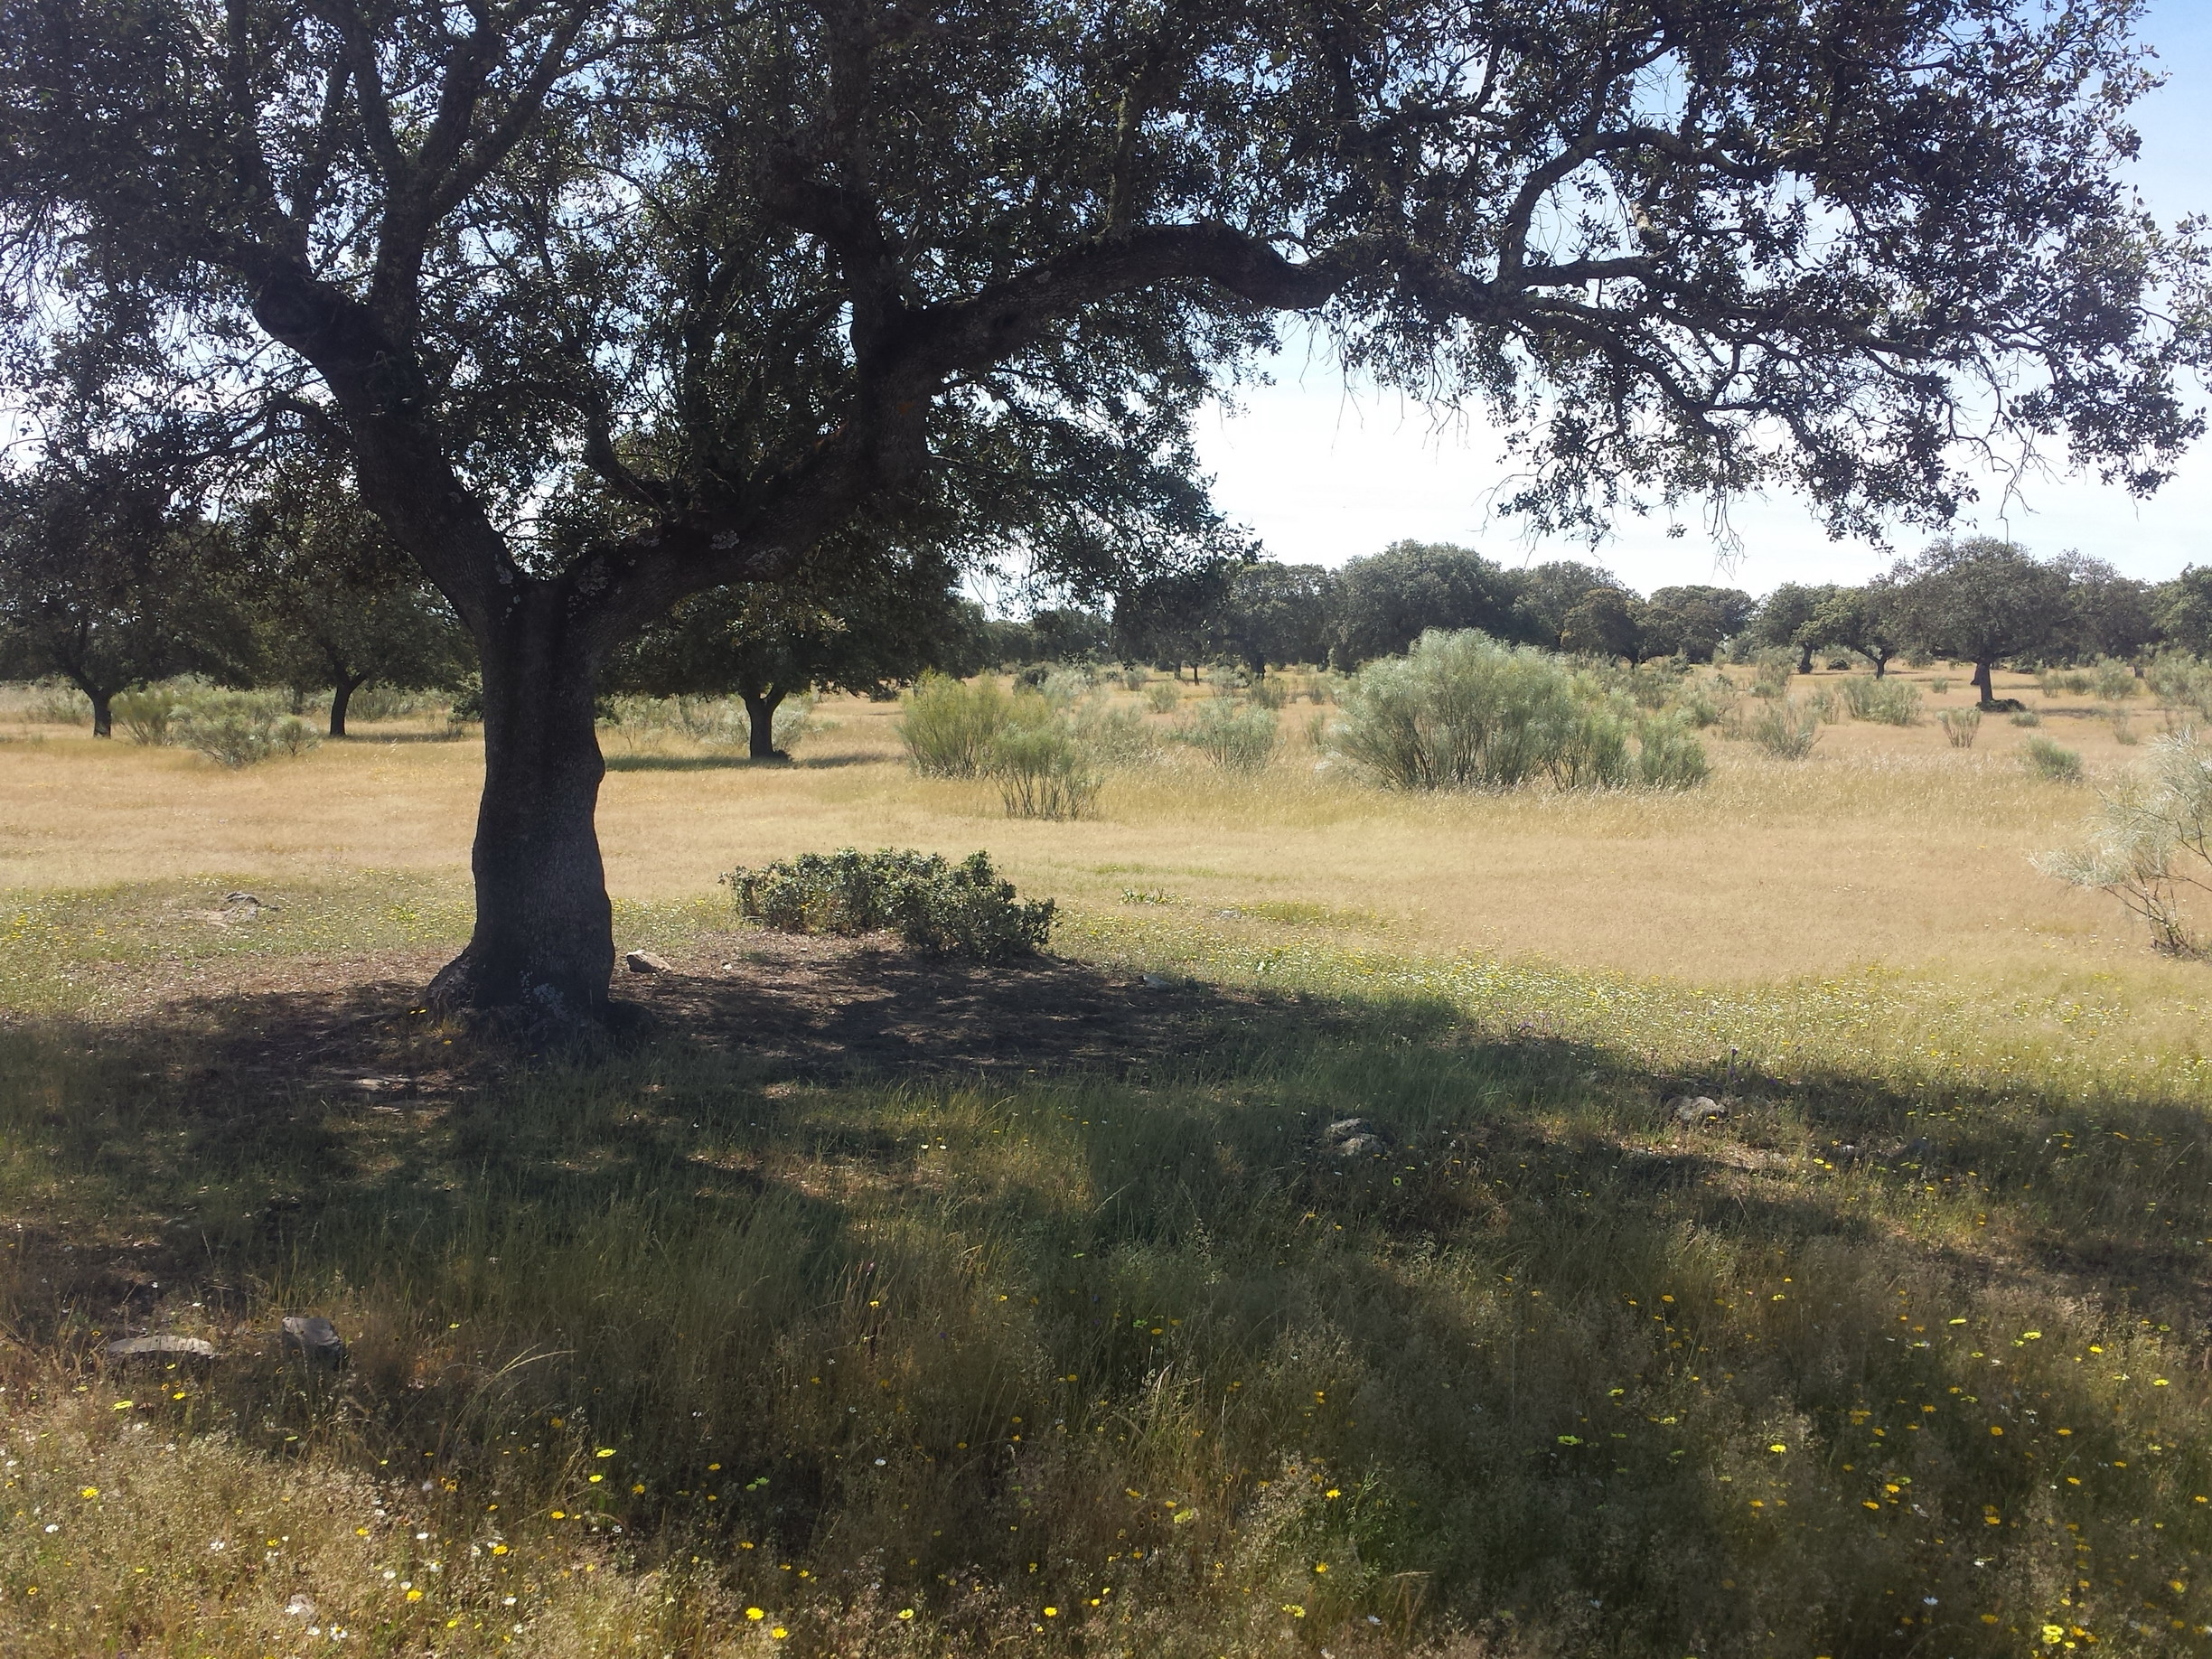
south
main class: Woodland
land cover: Broadleaved woodland
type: broadleaved evergreen forest
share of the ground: 10 - 25 %
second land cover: Grassland without tree/shrub cover
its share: > 75 %
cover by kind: herbaceous plants 85 %, broadleaved forest trees 15 %
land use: Forestry
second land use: Agriculture (excluding fallow land and kitchen gardens)
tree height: > 5 m
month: May
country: ES
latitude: 39.5667
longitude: -7.0911
